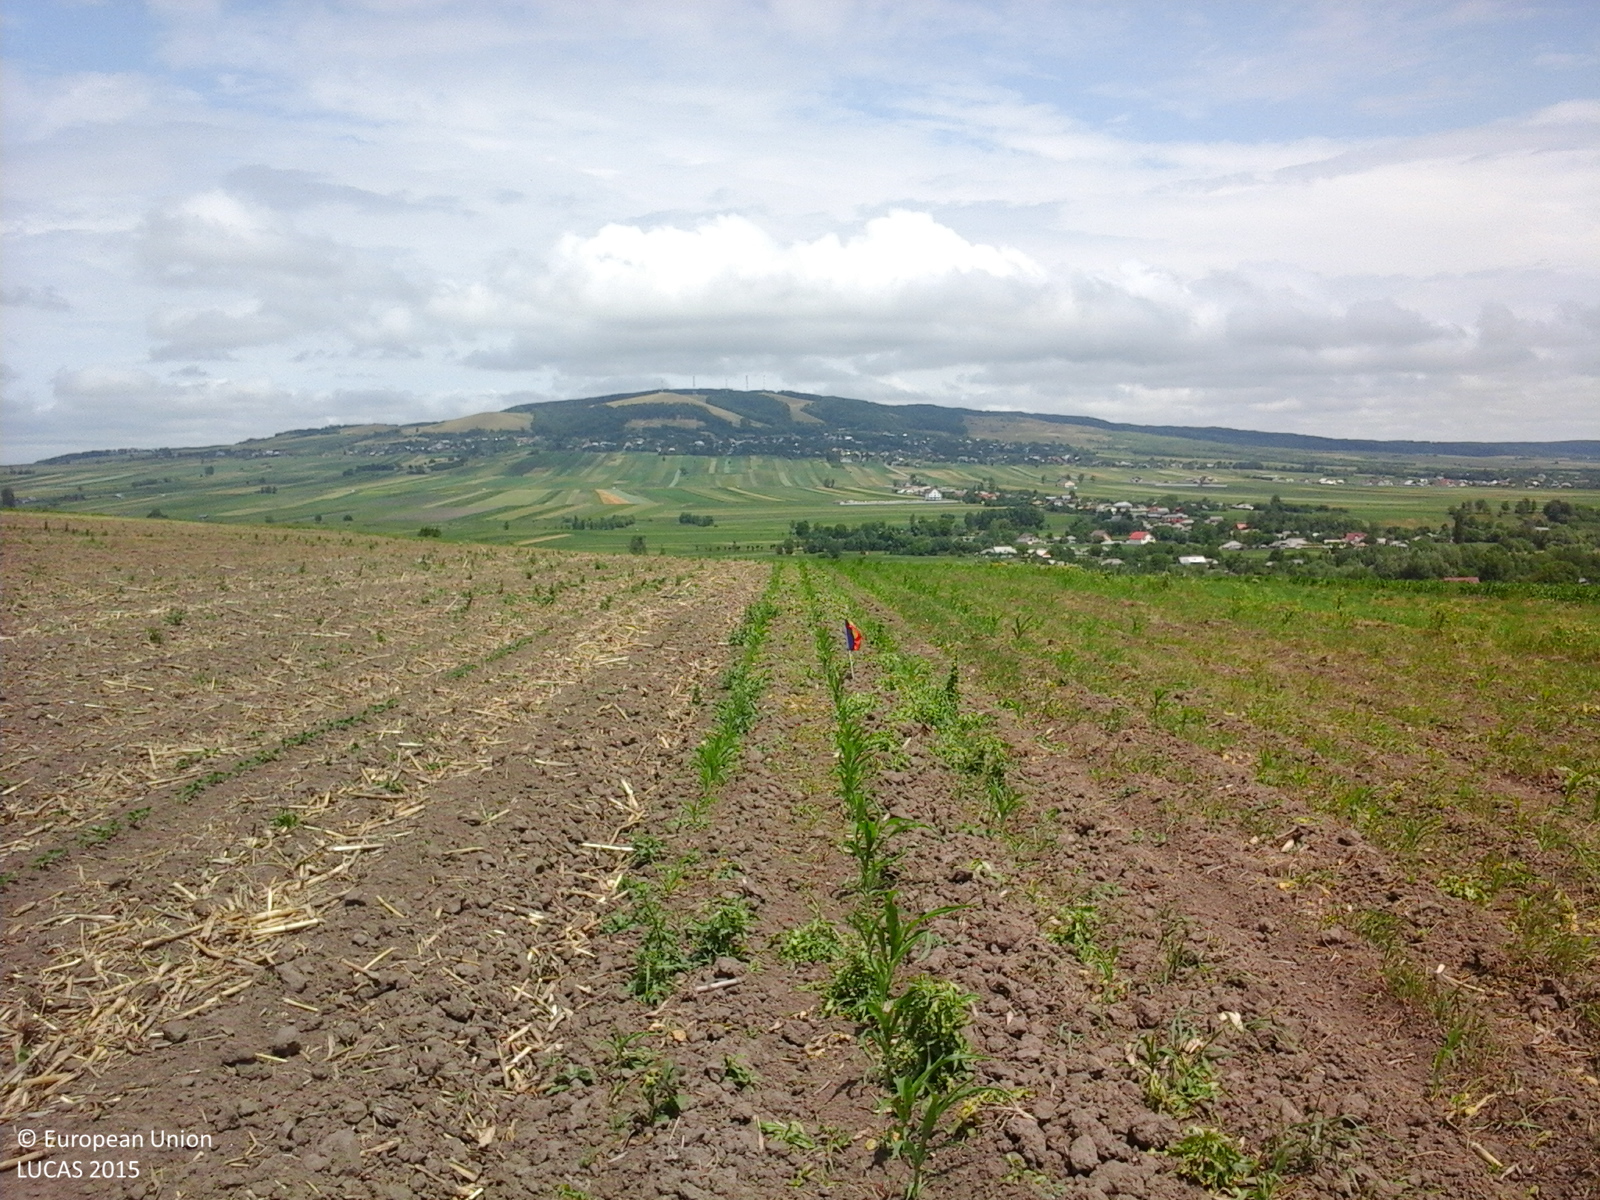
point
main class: Cropland
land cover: Maize
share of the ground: 25 - 50 %
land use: Agriculture (excluding fallow land and kitchen gardens)
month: May
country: RO
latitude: 47.1459
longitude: 26.4231
